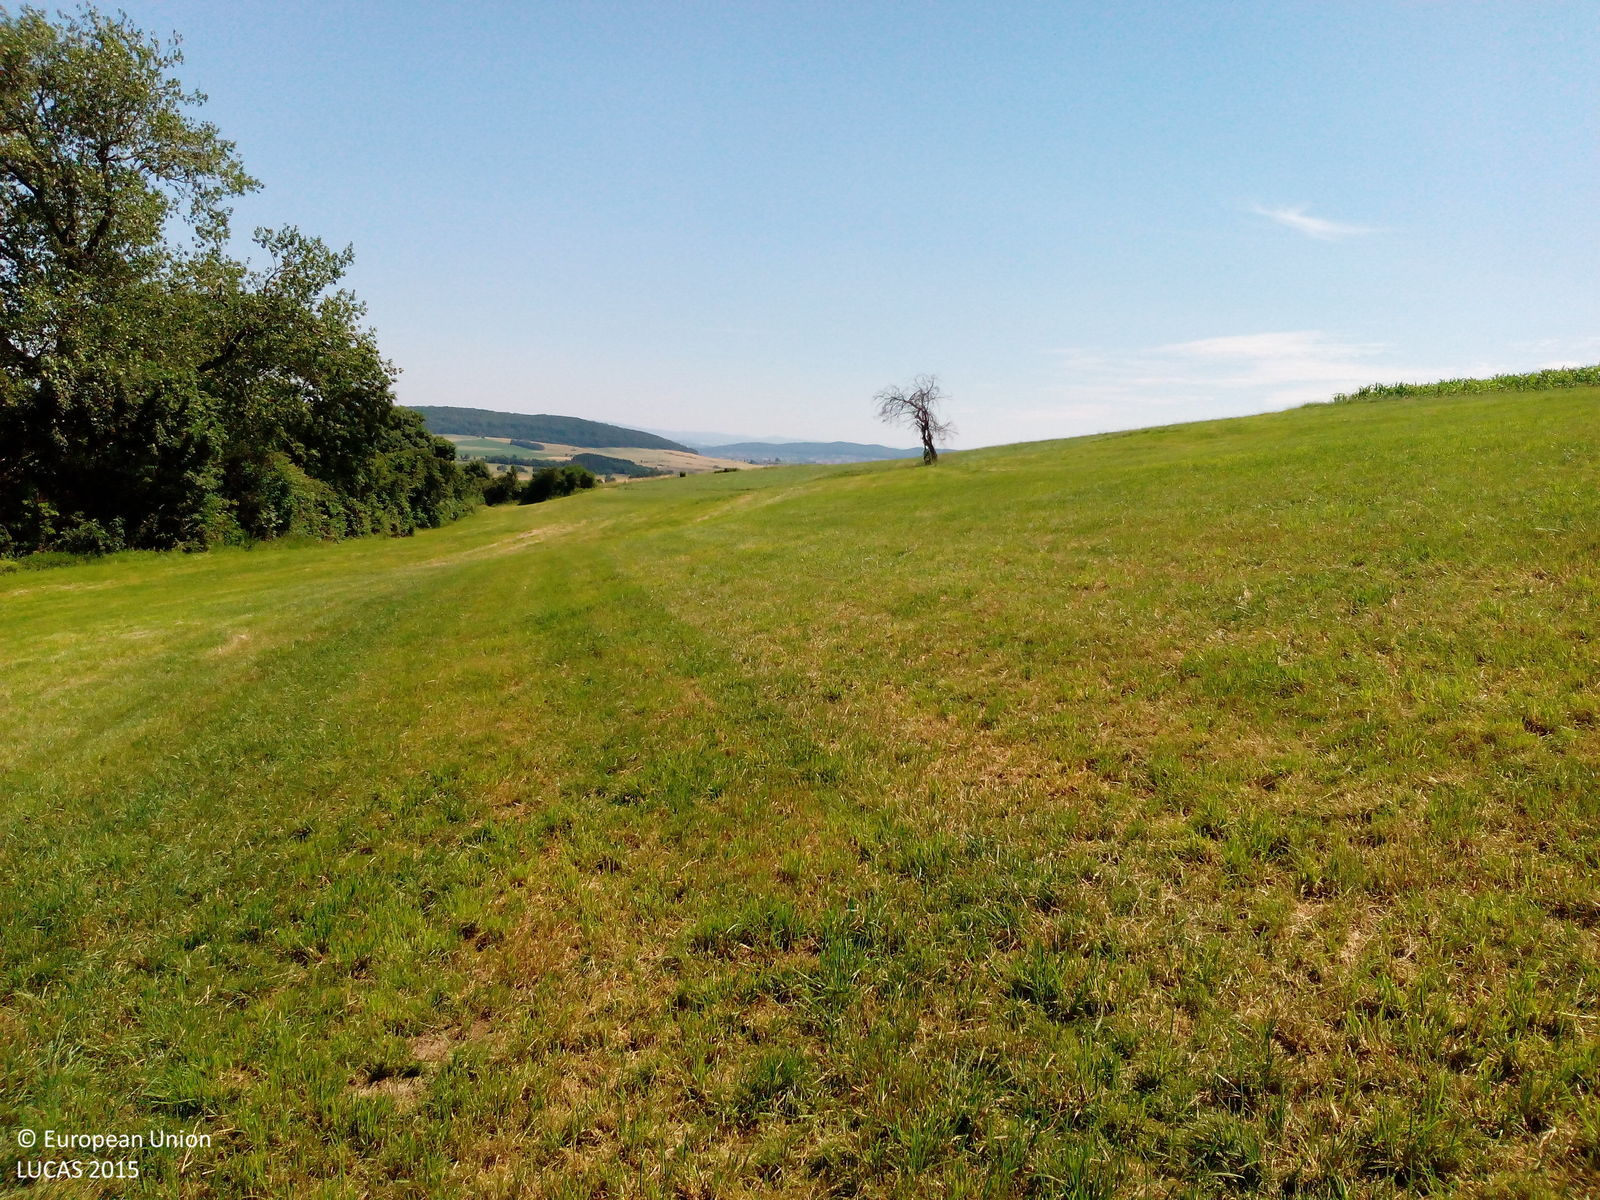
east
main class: Grassland
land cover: Grassland without tree/shrub cover
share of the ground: > 75 %
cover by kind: herbaceous plants 100 %
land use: Agriculture (excluding fallow land and kitchen gardens)
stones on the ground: < 10 %
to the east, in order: Grassland without tree/shrub cover
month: July
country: DE
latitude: 51.7123
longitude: 9.8408
